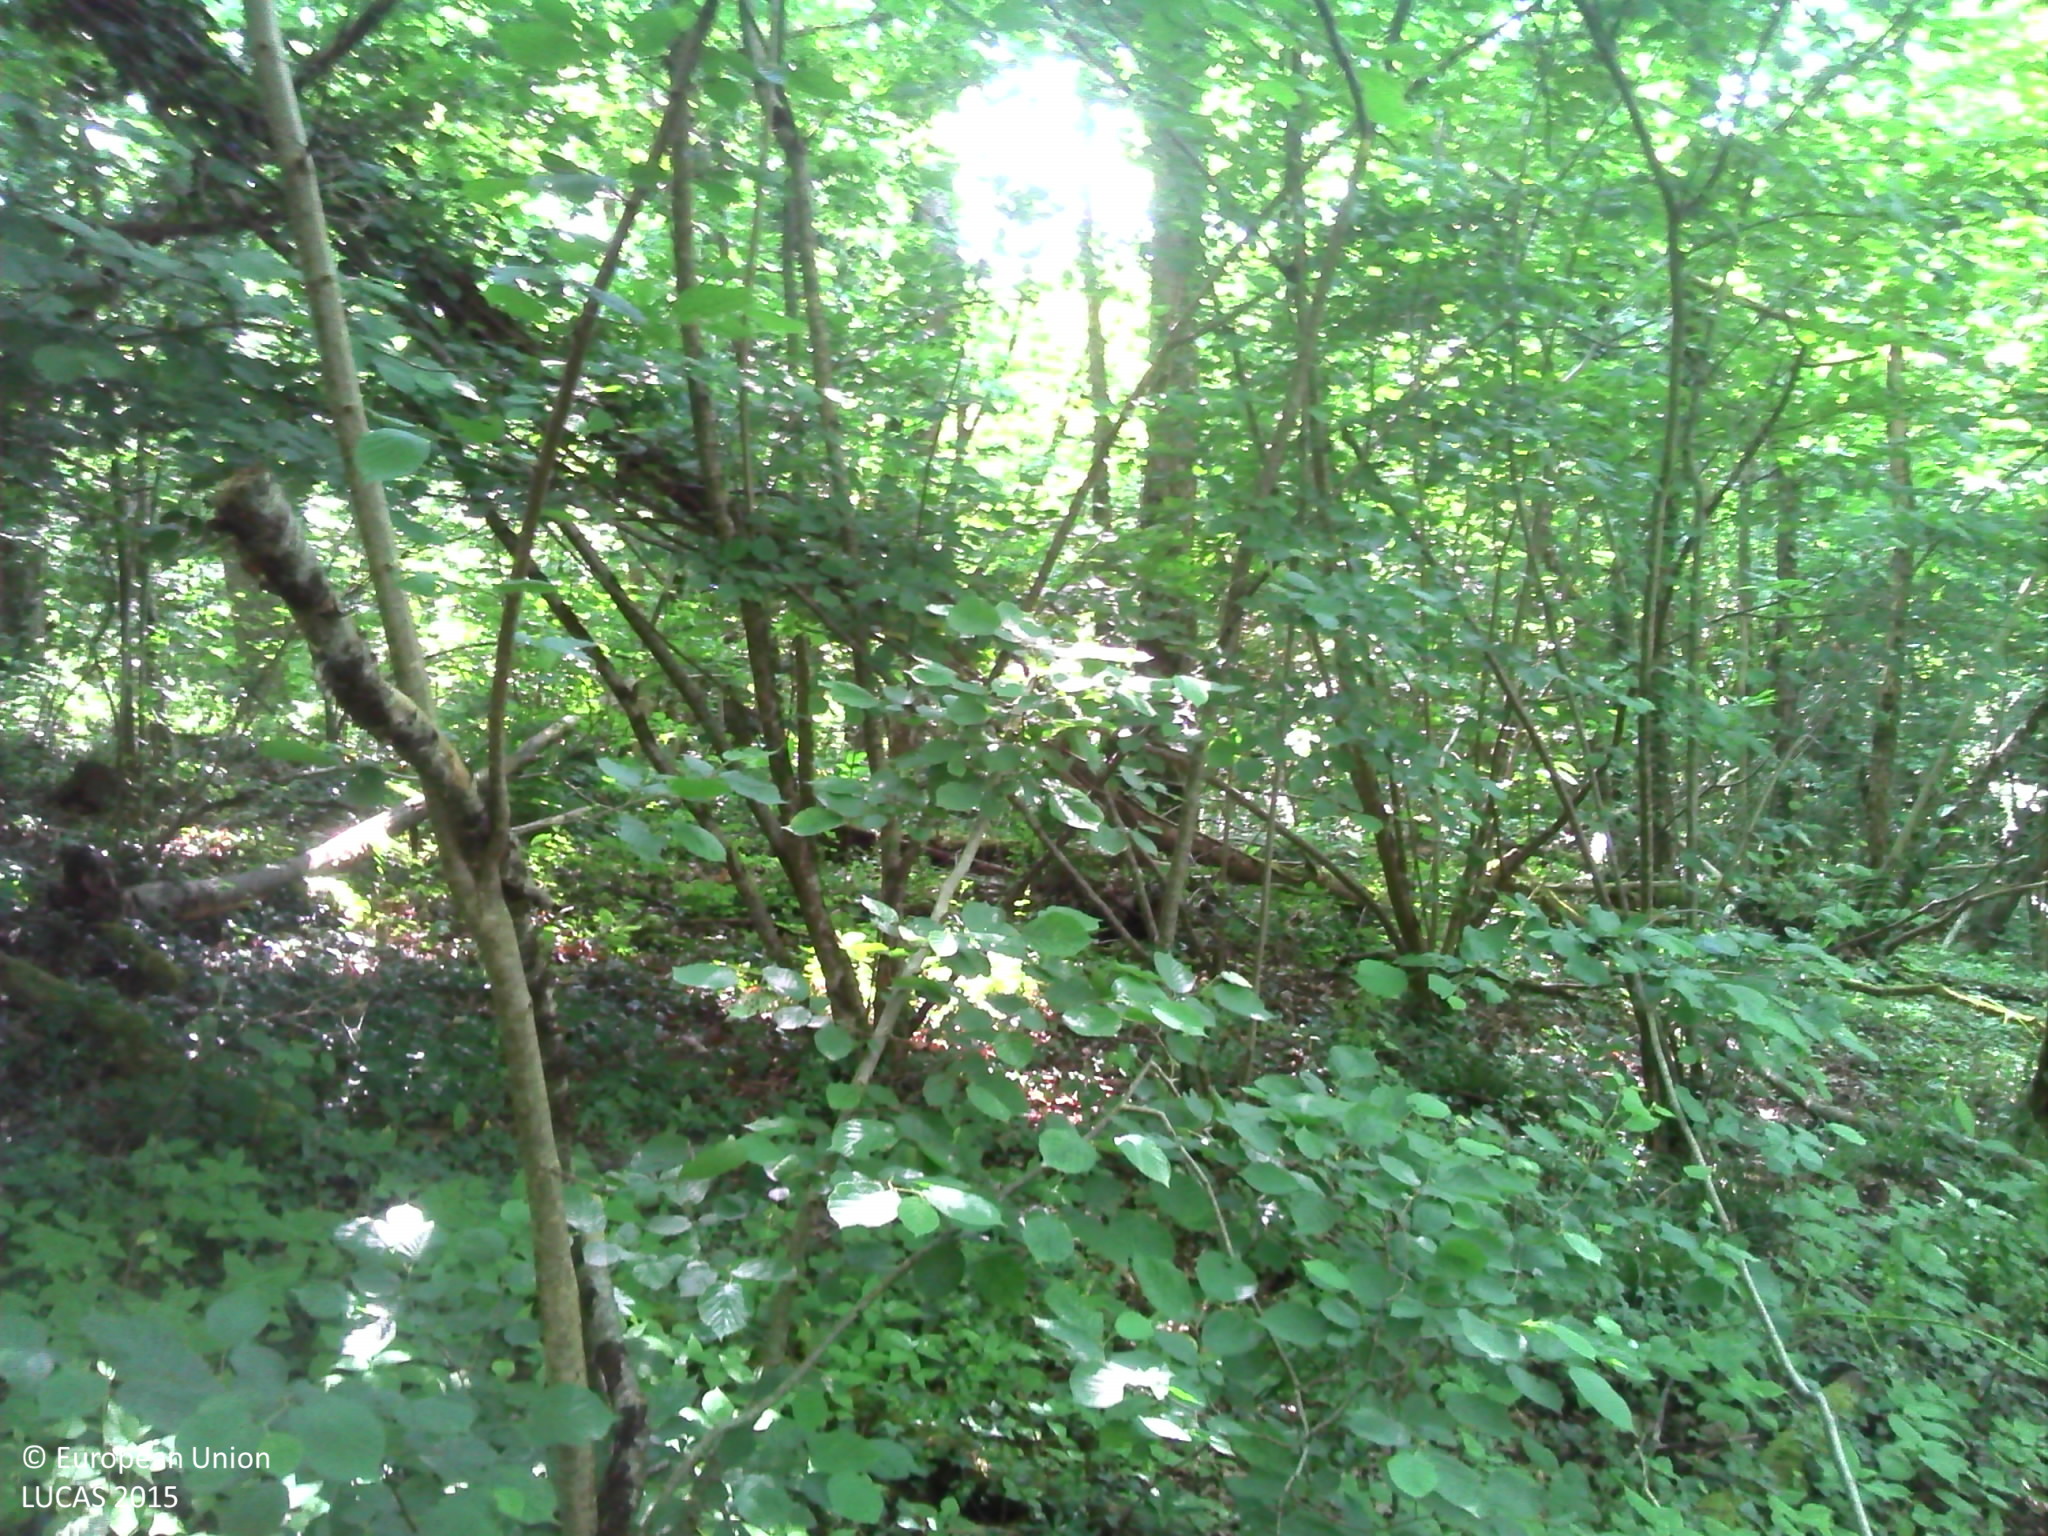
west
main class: Woodland
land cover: Broadleaved woodland
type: mesophytic deciduous forest
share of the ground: > 75 %
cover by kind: broadleaved forest trees 75 %, shrubs 10 %, herbaceous plants 10 %, lichens and mosses 5 %
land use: Forestry
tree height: > 5 m
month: June
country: FR
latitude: 47.5282
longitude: 0.7761
